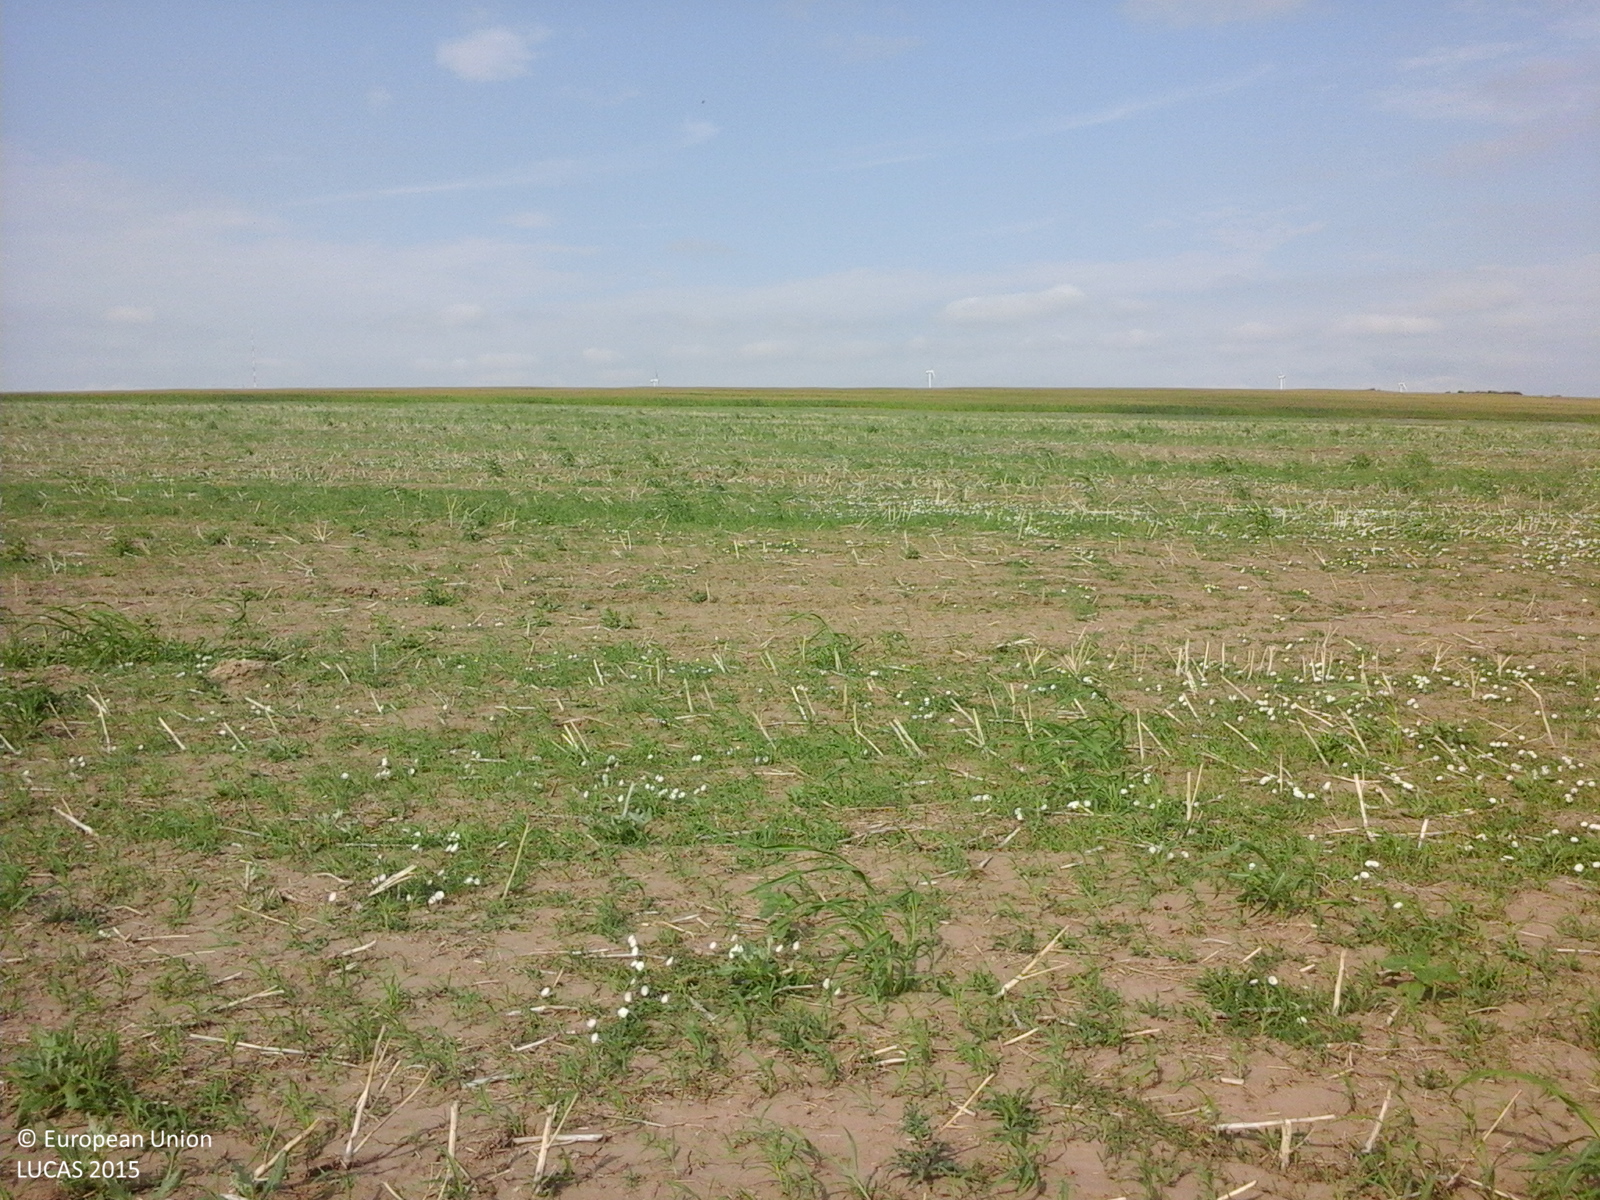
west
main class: Cropland
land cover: Rape and turnip rape
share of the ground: 10 - 25 %
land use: Agriculture (excluding fallow land and kitchen gardens)
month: August
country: RO
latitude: 45.0916
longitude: 28.9897
